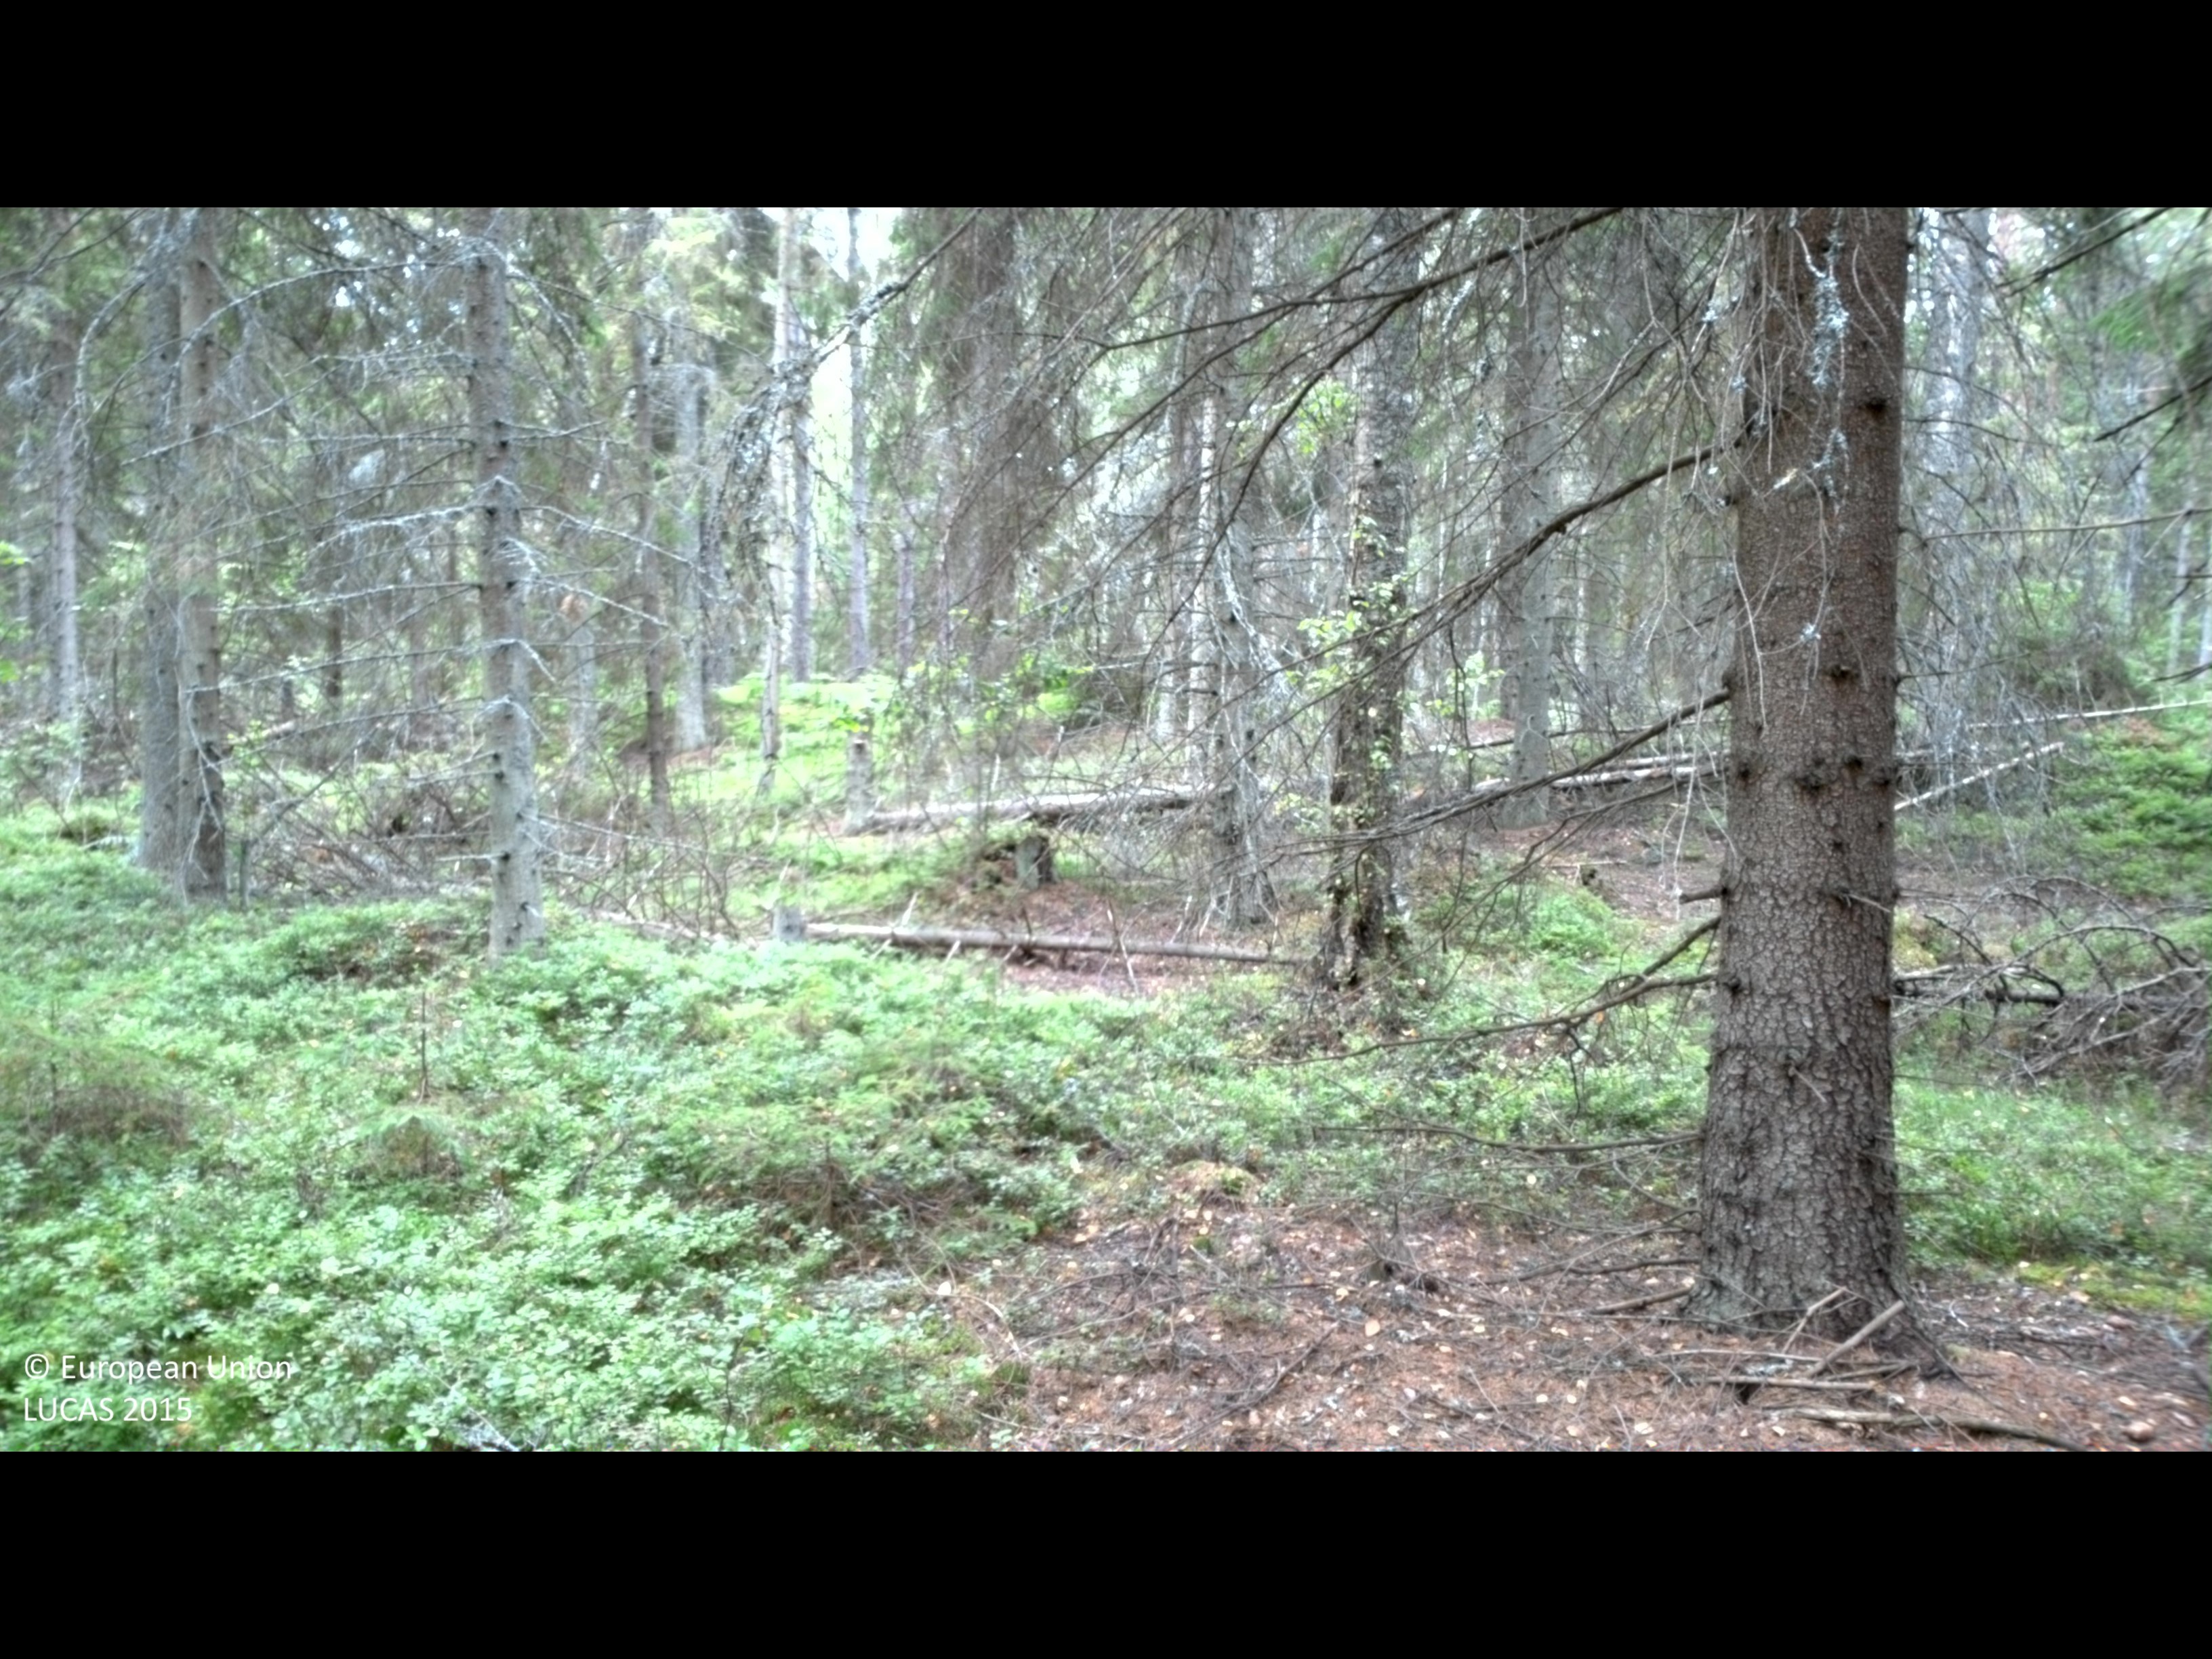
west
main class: Woodland
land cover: Spruce dominated coniferous woodland
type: boreal forest
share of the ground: > 75 %
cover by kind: coniferous forest trees 75 %, shrubs 15 %, herbaceous plants 5 %, lichens and mosses 5 %
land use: Forestry
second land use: Amenities, museums, leisure
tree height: > 5 m
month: July
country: SE
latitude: 57.2937
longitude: 17.0541
